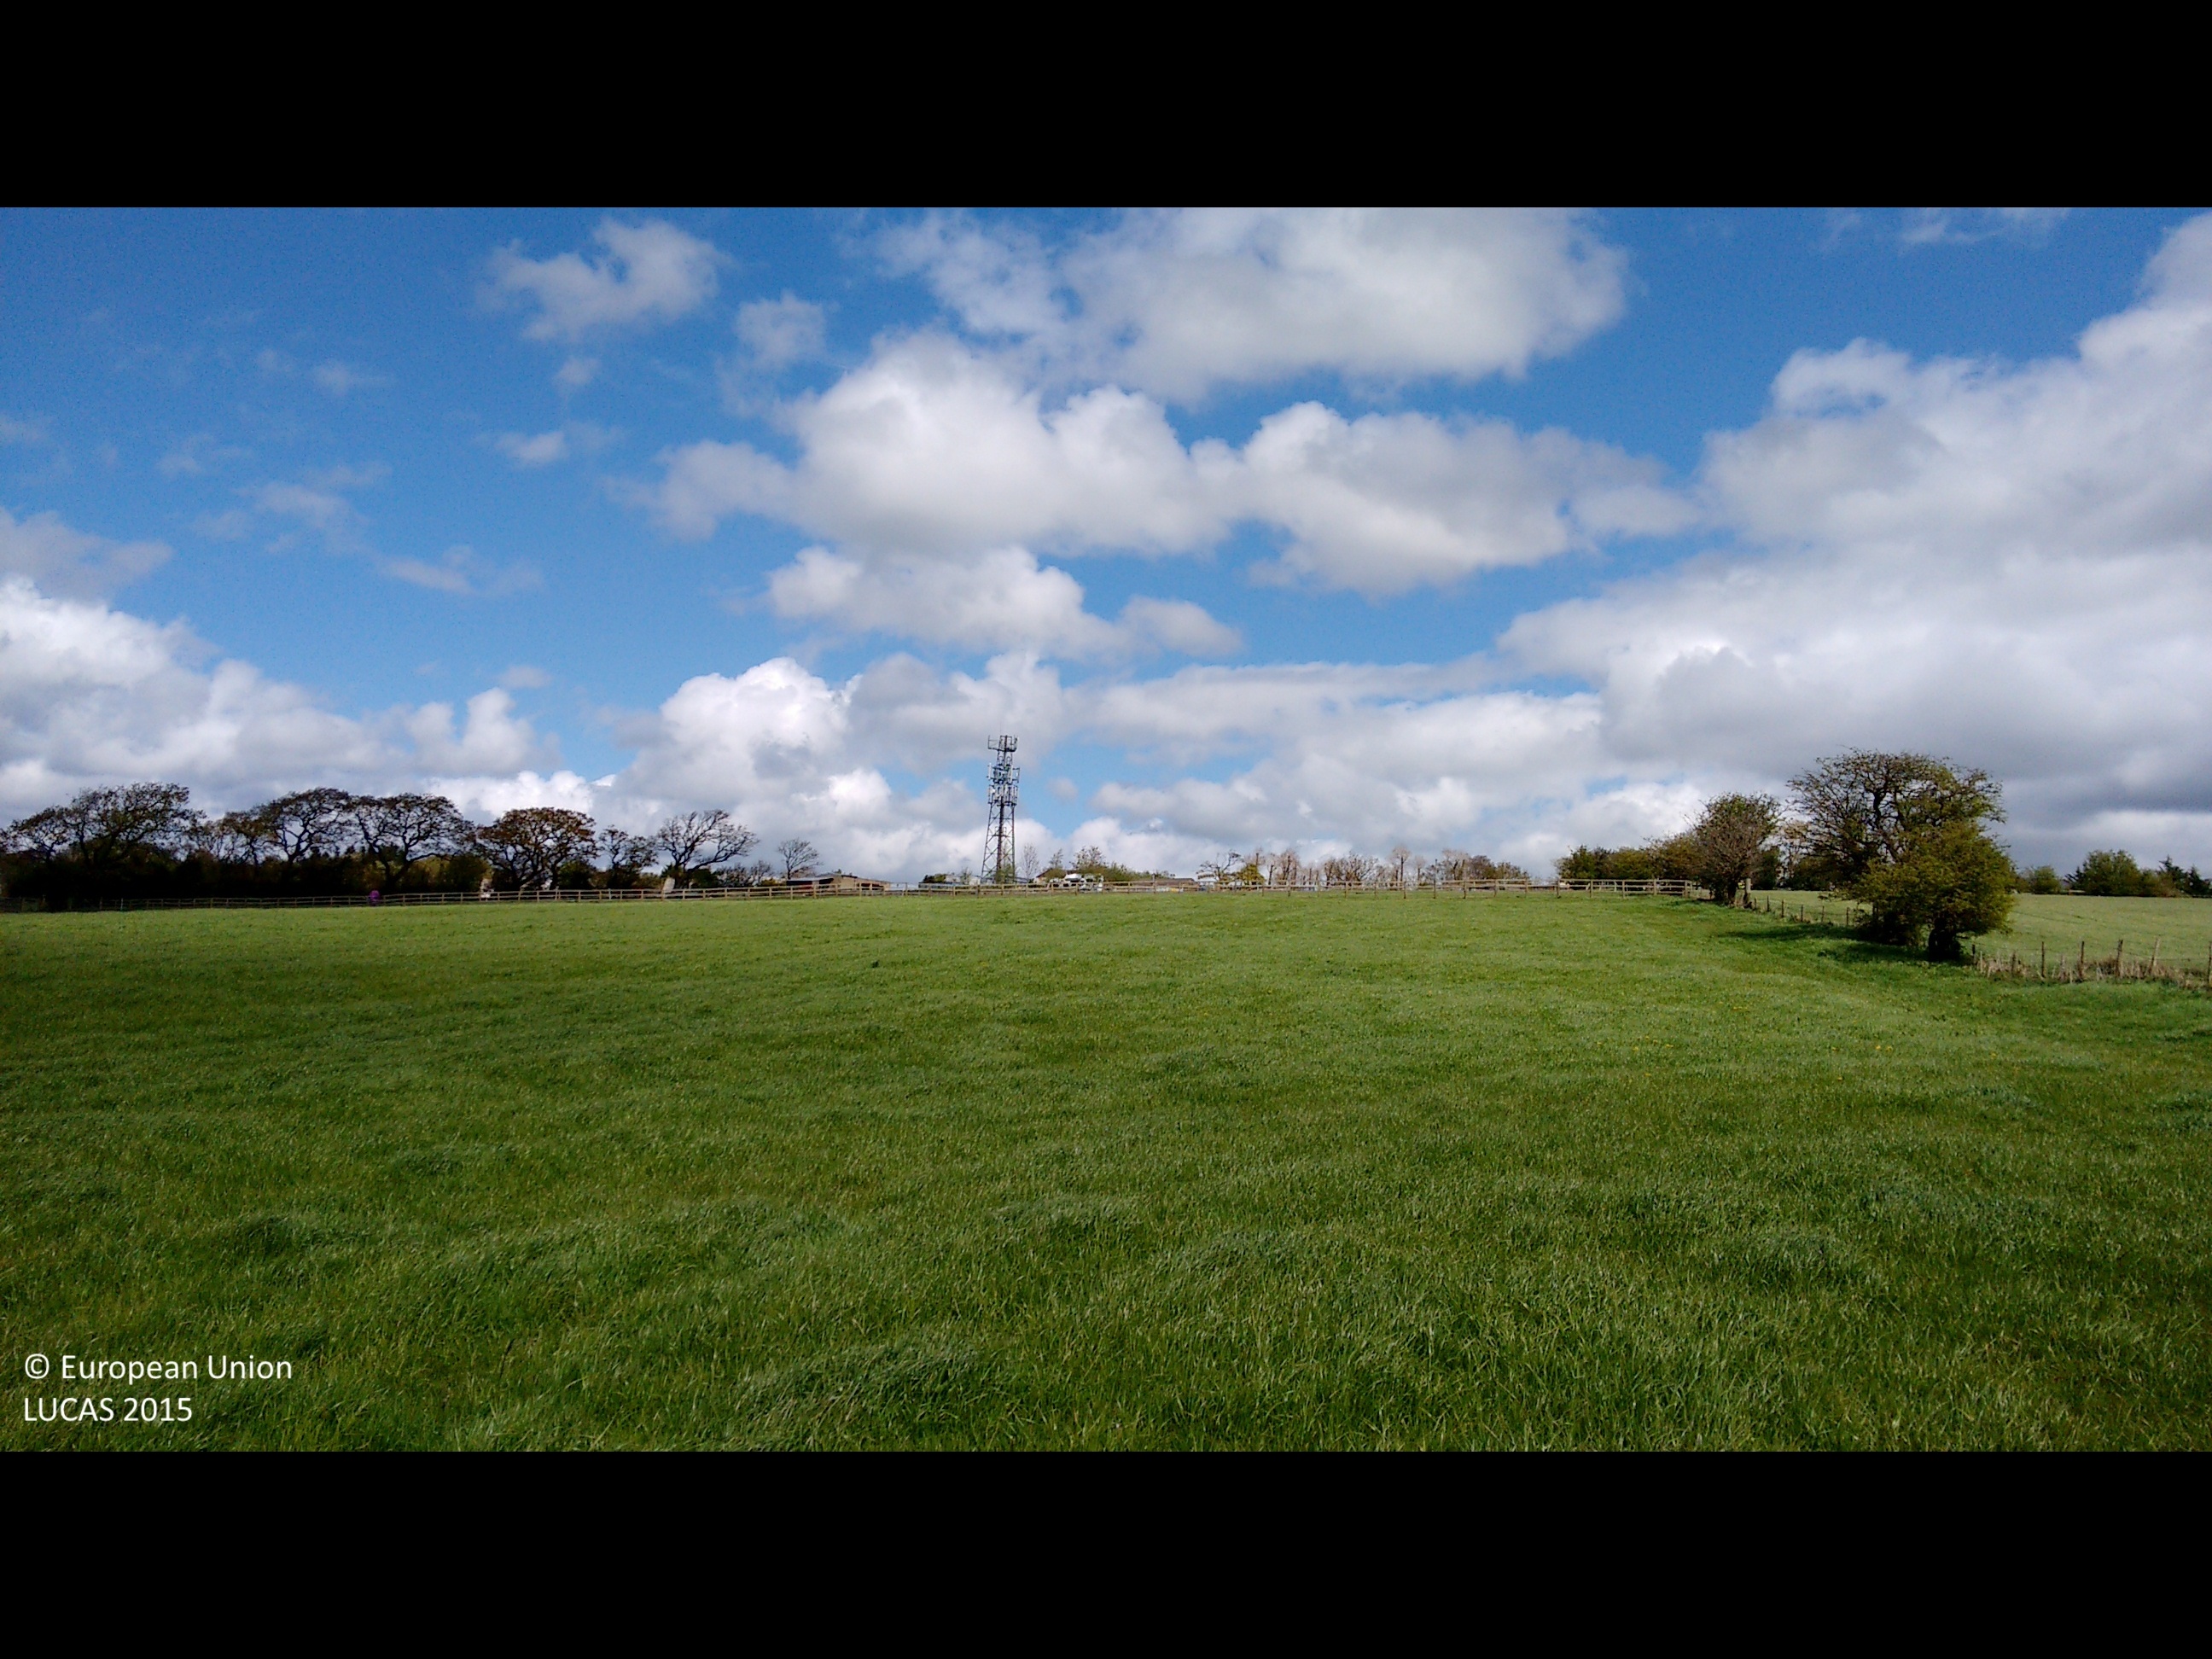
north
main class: Grassland
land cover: Grassland without tree/shrub cover
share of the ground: > 75 %
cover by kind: herbaceous plants 100 %
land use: Agriculture (excluding fallow land and kitchen gardens)
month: May
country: GB
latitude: 53.7891
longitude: -2.4966
